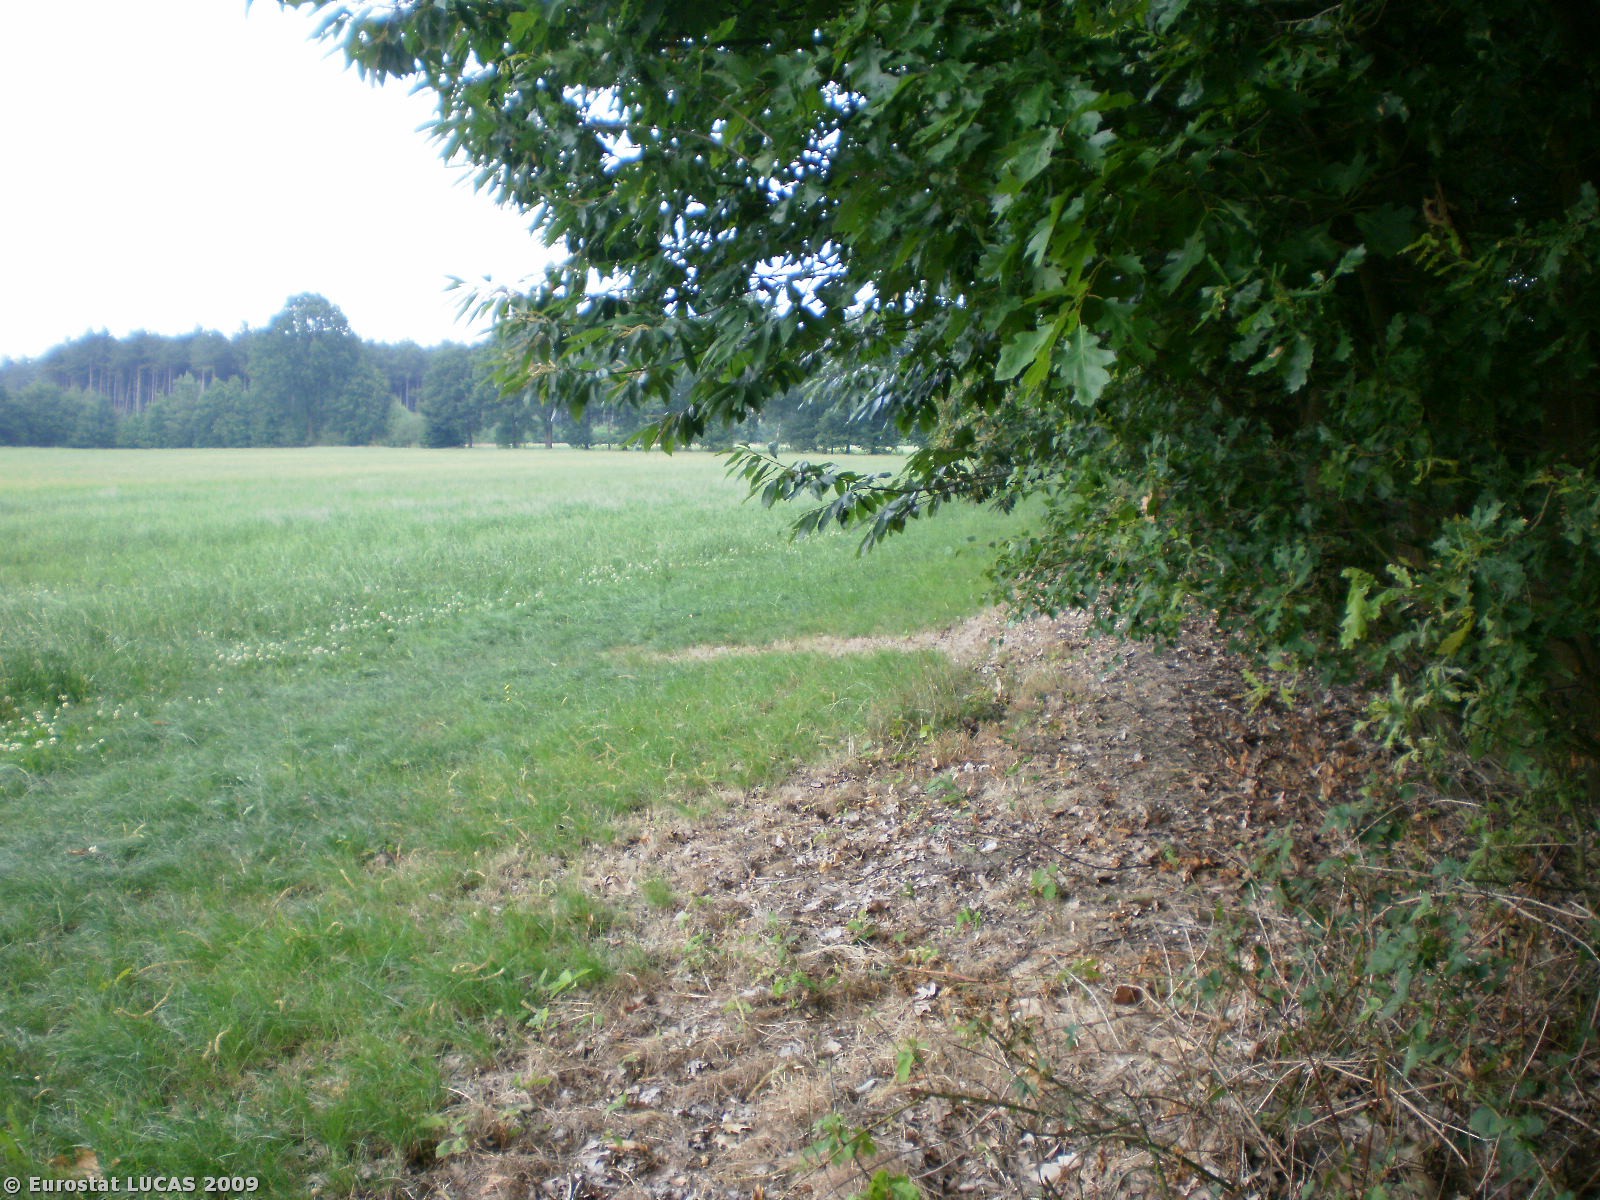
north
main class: Grassland
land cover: Grassland without tree/shrub cover
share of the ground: > 75 %
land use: Agriculture (excluding fallow land and kitchen gardens)
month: July
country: BE
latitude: 51.1555
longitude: 5.4371
